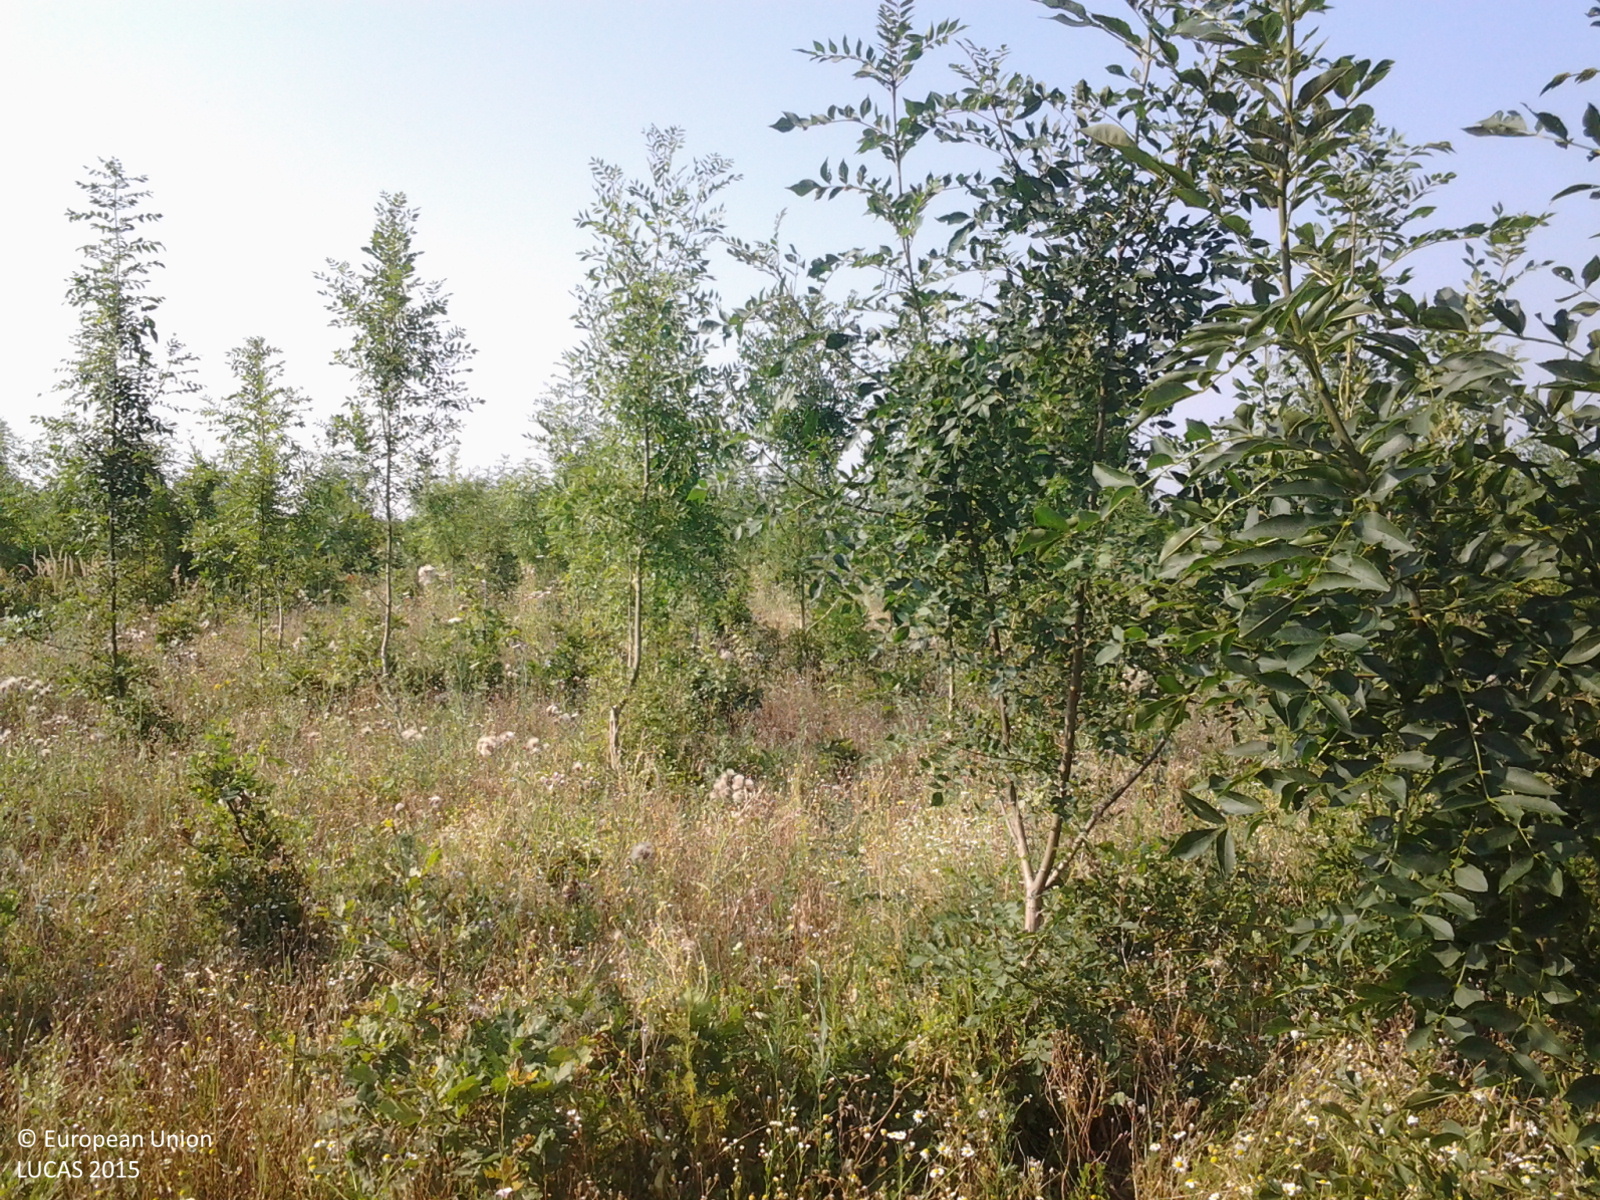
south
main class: Woodland
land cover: Broadleaved woodland
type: mesophytic deciduous forest
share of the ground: > 75 %
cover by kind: broadleaved forest trees 75 %, herbaceous plants 20 %, shrubs 5 %
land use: Forestry
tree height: < 5 m
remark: Nursery
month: July
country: HU
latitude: 46.7561
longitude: 21.4148
